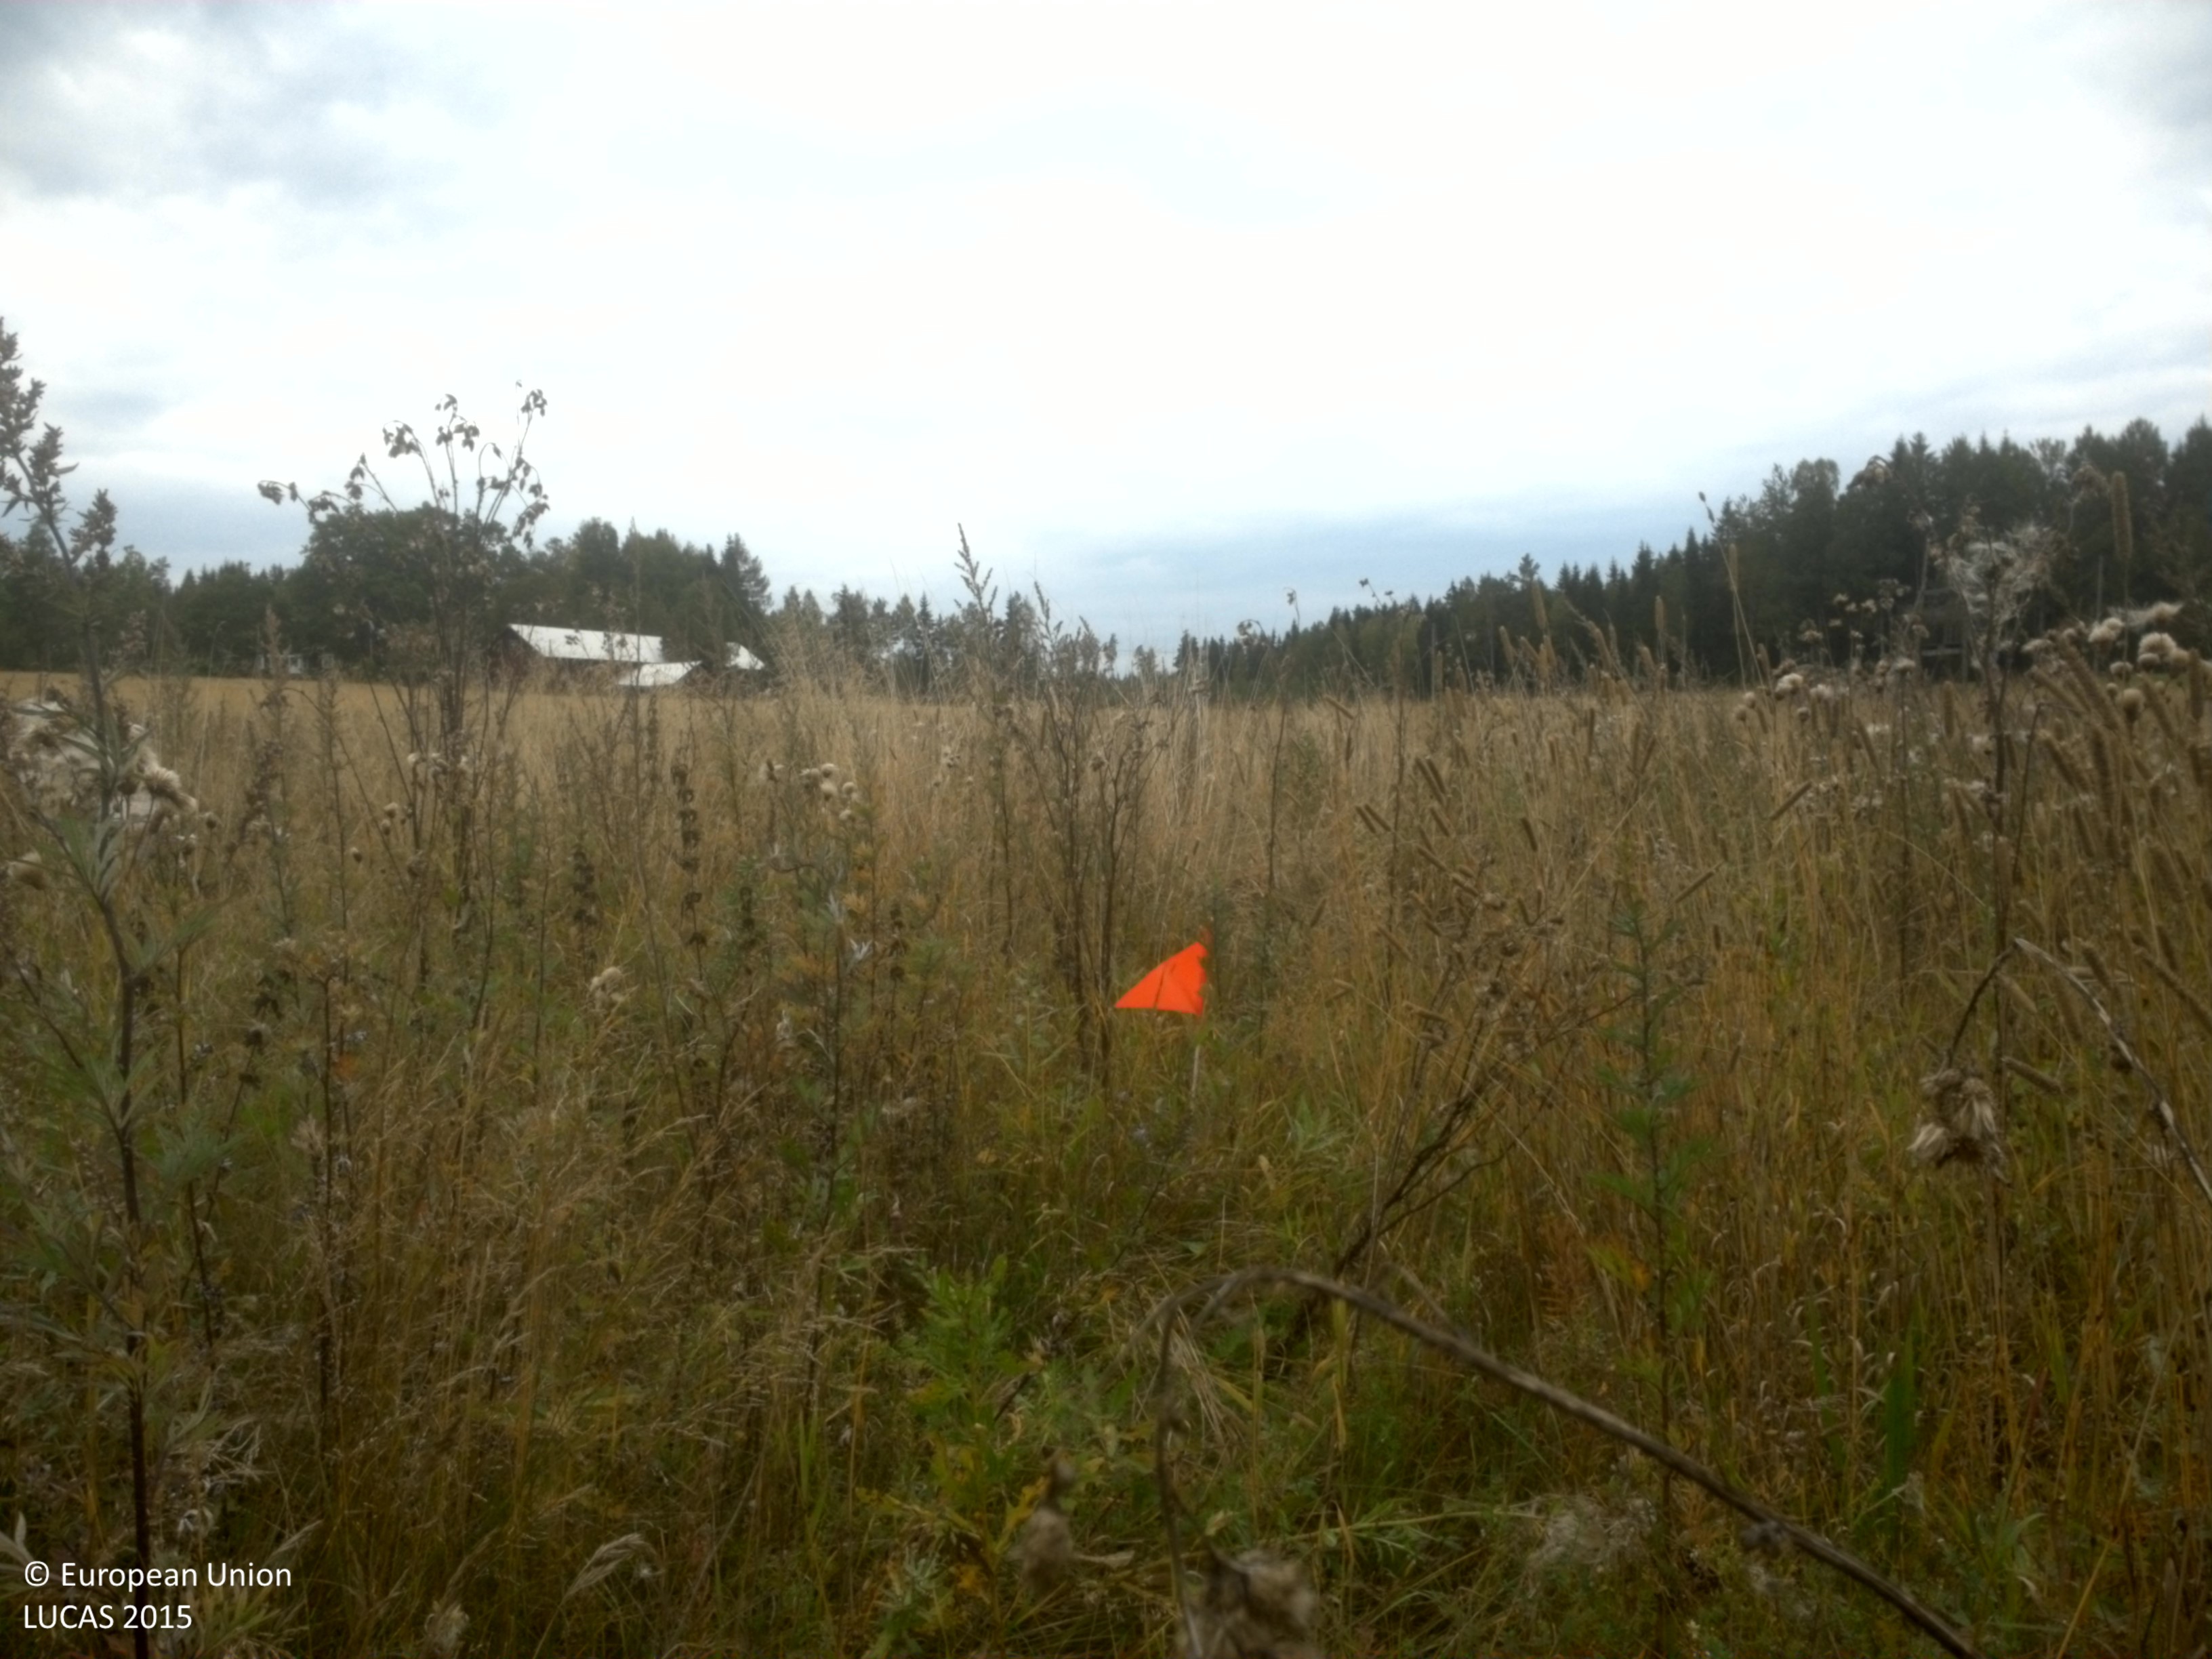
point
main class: Grassland
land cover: Spontaneously vegetated surfaces
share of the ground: > 75 %
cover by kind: herbaceous plants 100 %
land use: Agriculture (excluding fallow land and kitchen gardens)
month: September
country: SE
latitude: 59.5697
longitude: 15.4604
